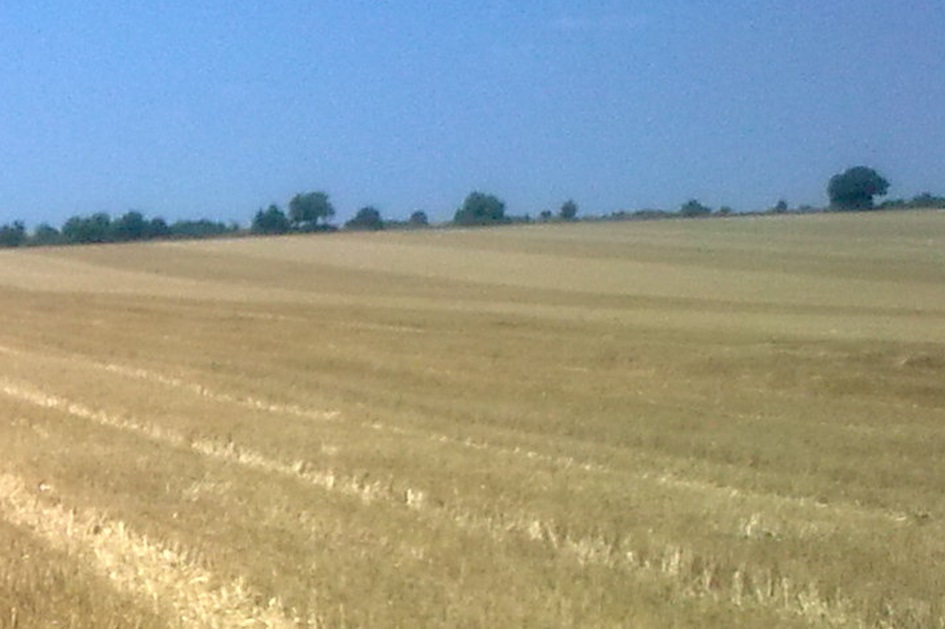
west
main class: Cropland
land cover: Common wheat
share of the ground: > 75 %
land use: Agriculture (excluding fallow land and kitchen gardens)
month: July
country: BG
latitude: 43.7948
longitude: 26.2459
